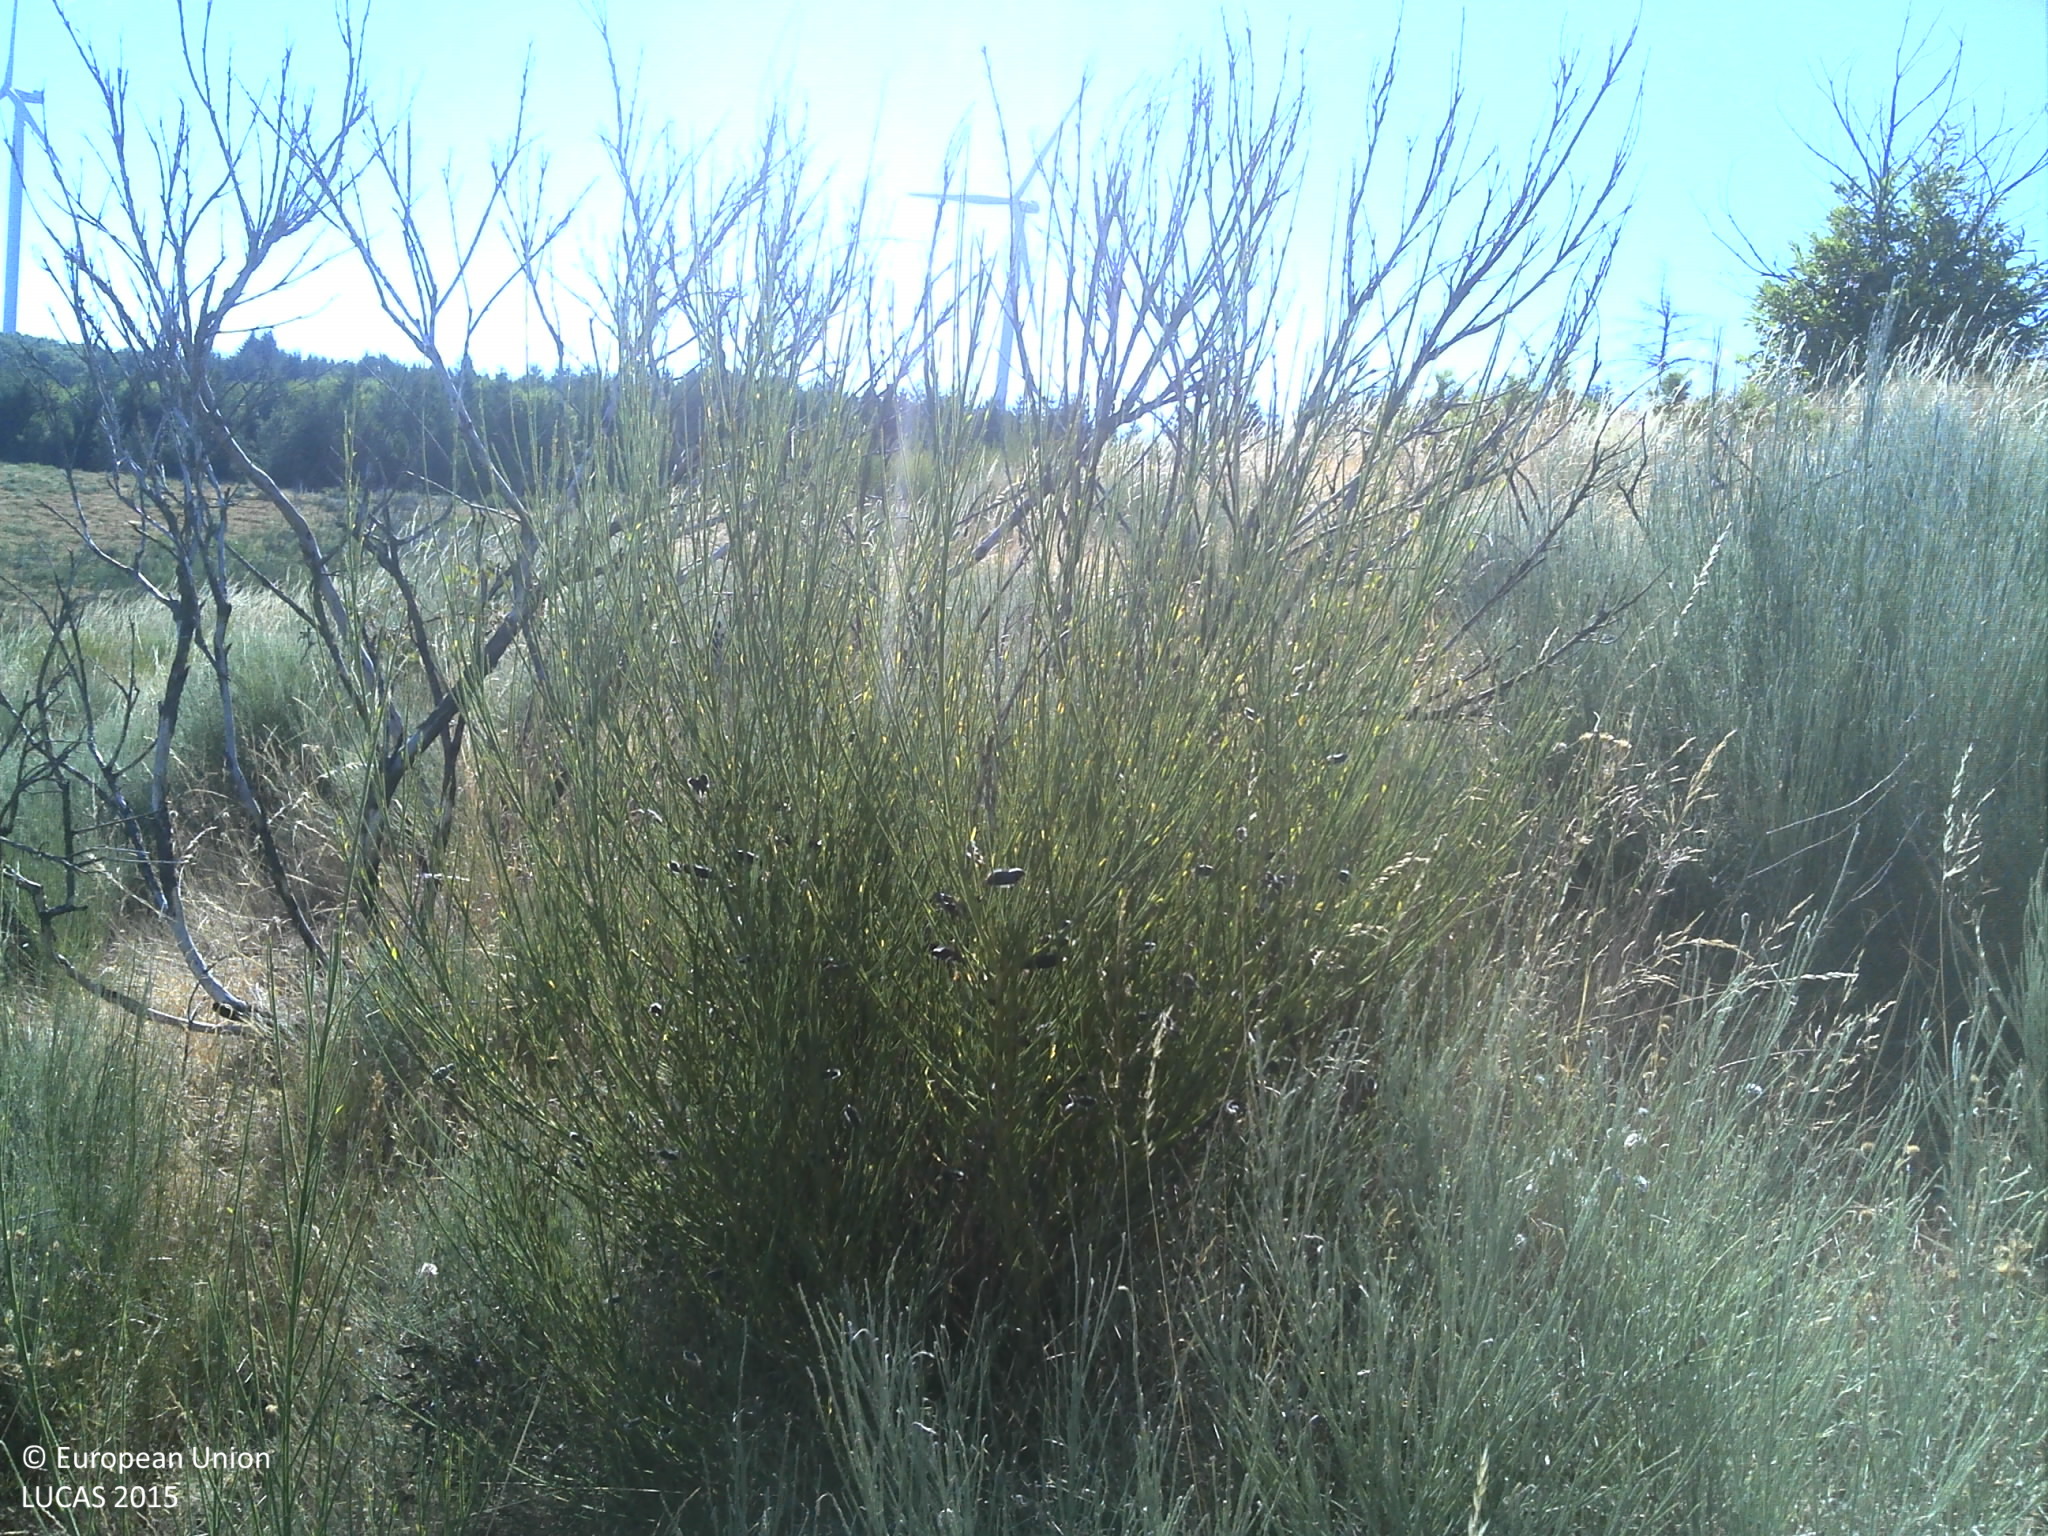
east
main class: Shrubland
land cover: Shrubland without tree cover
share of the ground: > 75 %
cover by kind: shrubs 95 %, herbaceous plants 5 %
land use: Abandoned areas
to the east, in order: Shrubland without tree cover; Tracks; Other coniferous woodland
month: July
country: PT
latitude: 41.4436
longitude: -7.0021
